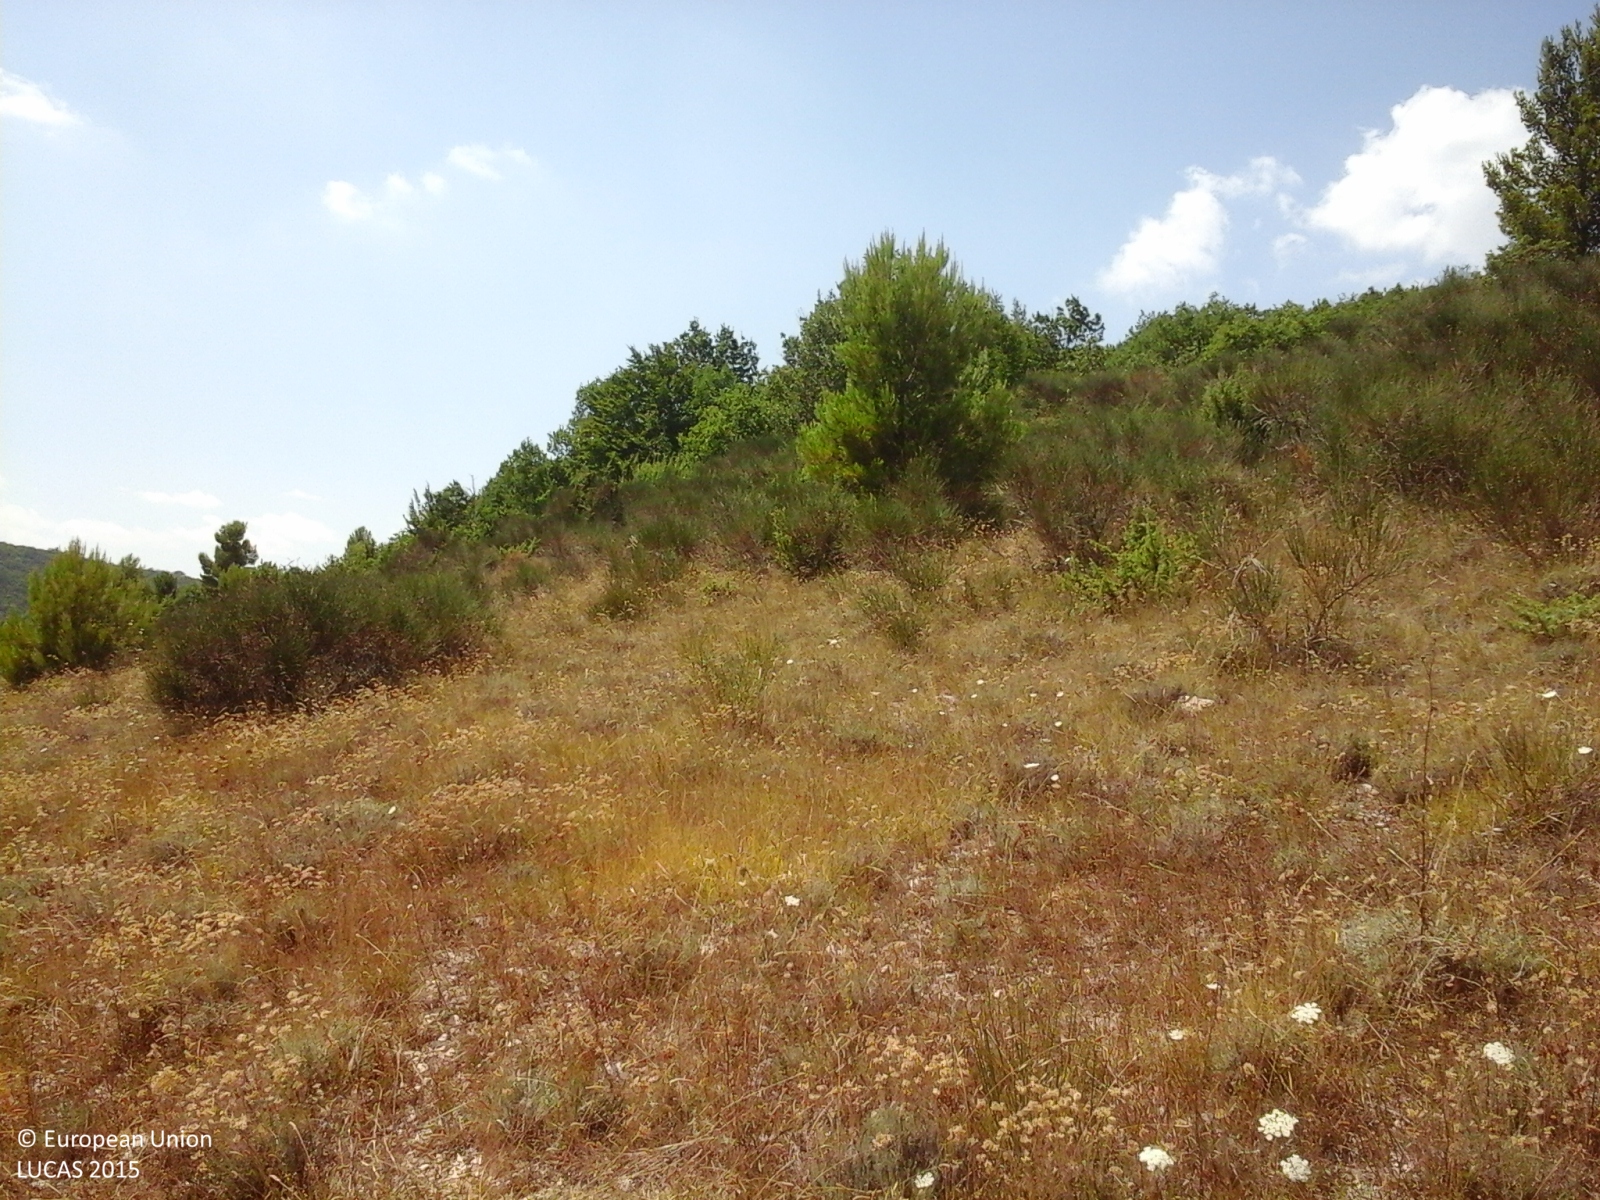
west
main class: Grassland
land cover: Grassland without tree/shrub cover
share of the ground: > 75 %
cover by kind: herbaceous plants 95 %, shrubs 5 %
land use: Agriculture (excluding fallow land and kitchen gardens)
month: August
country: IT
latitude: 43.3432
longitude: 13.2359
